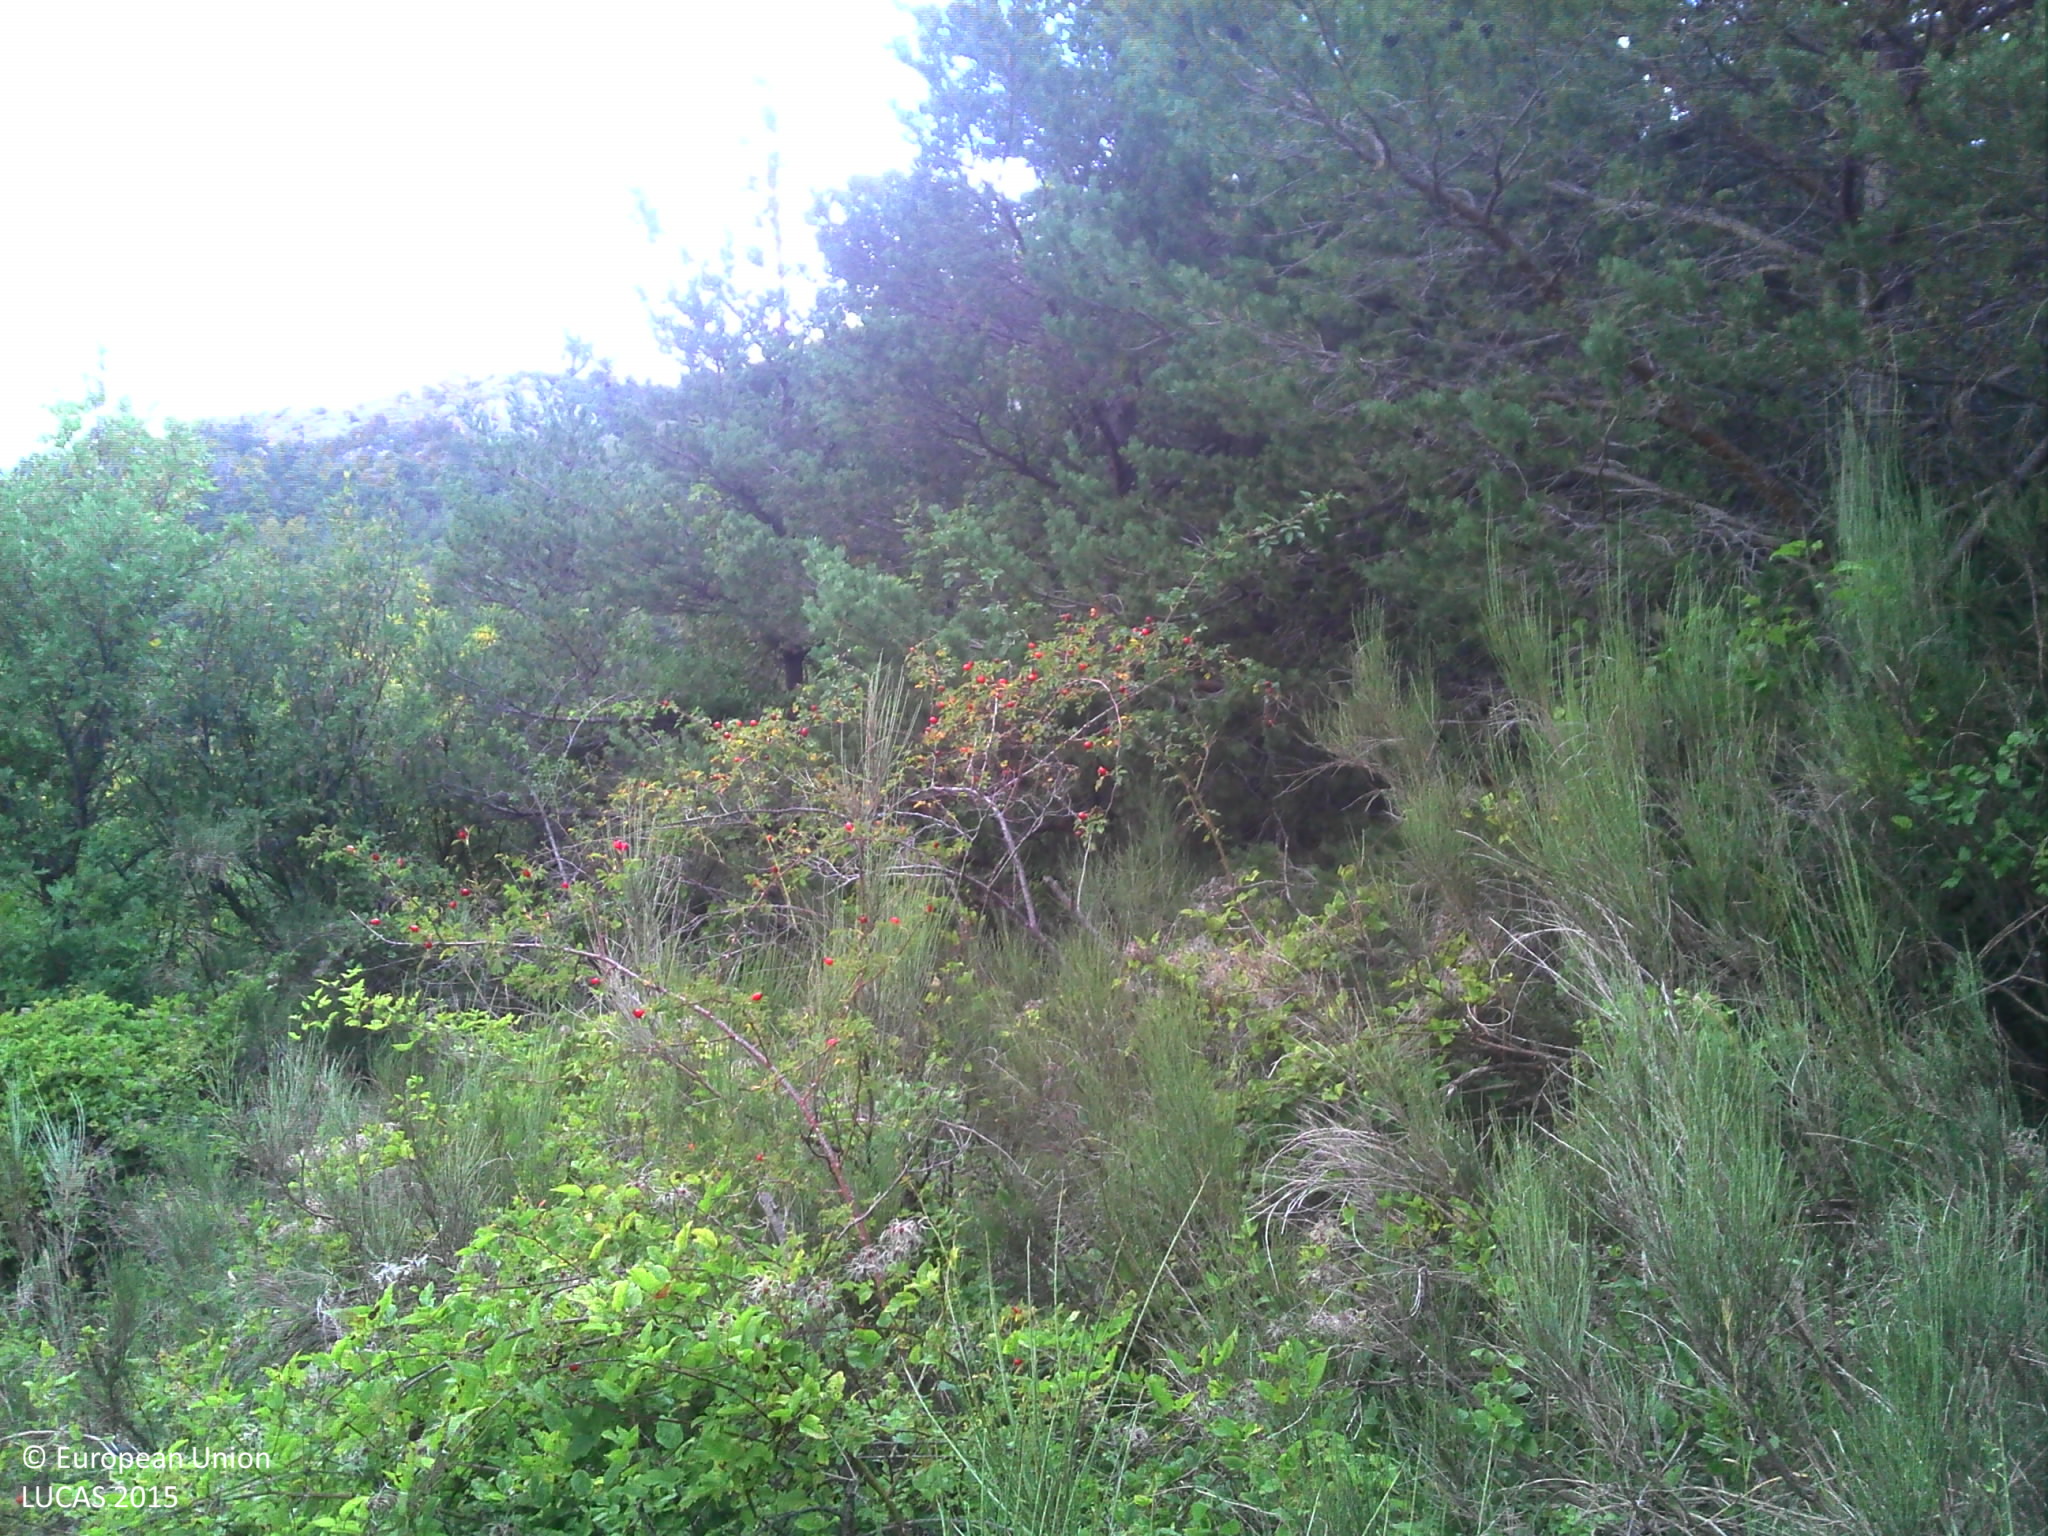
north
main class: Woodland
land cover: Pine dominated coniferous woodland
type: alpine coniferous forest
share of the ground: > 75 %
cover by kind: coniferous forest trees 75 %, shrubs 10 %, broadleaved forest trees 5 %, herbaceous plants 5 %, consolidated bare surface 5 %
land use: Forestry
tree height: > 5 m
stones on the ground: < 10 %
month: September
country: FR
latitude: 44.4367
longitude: 5.5723
